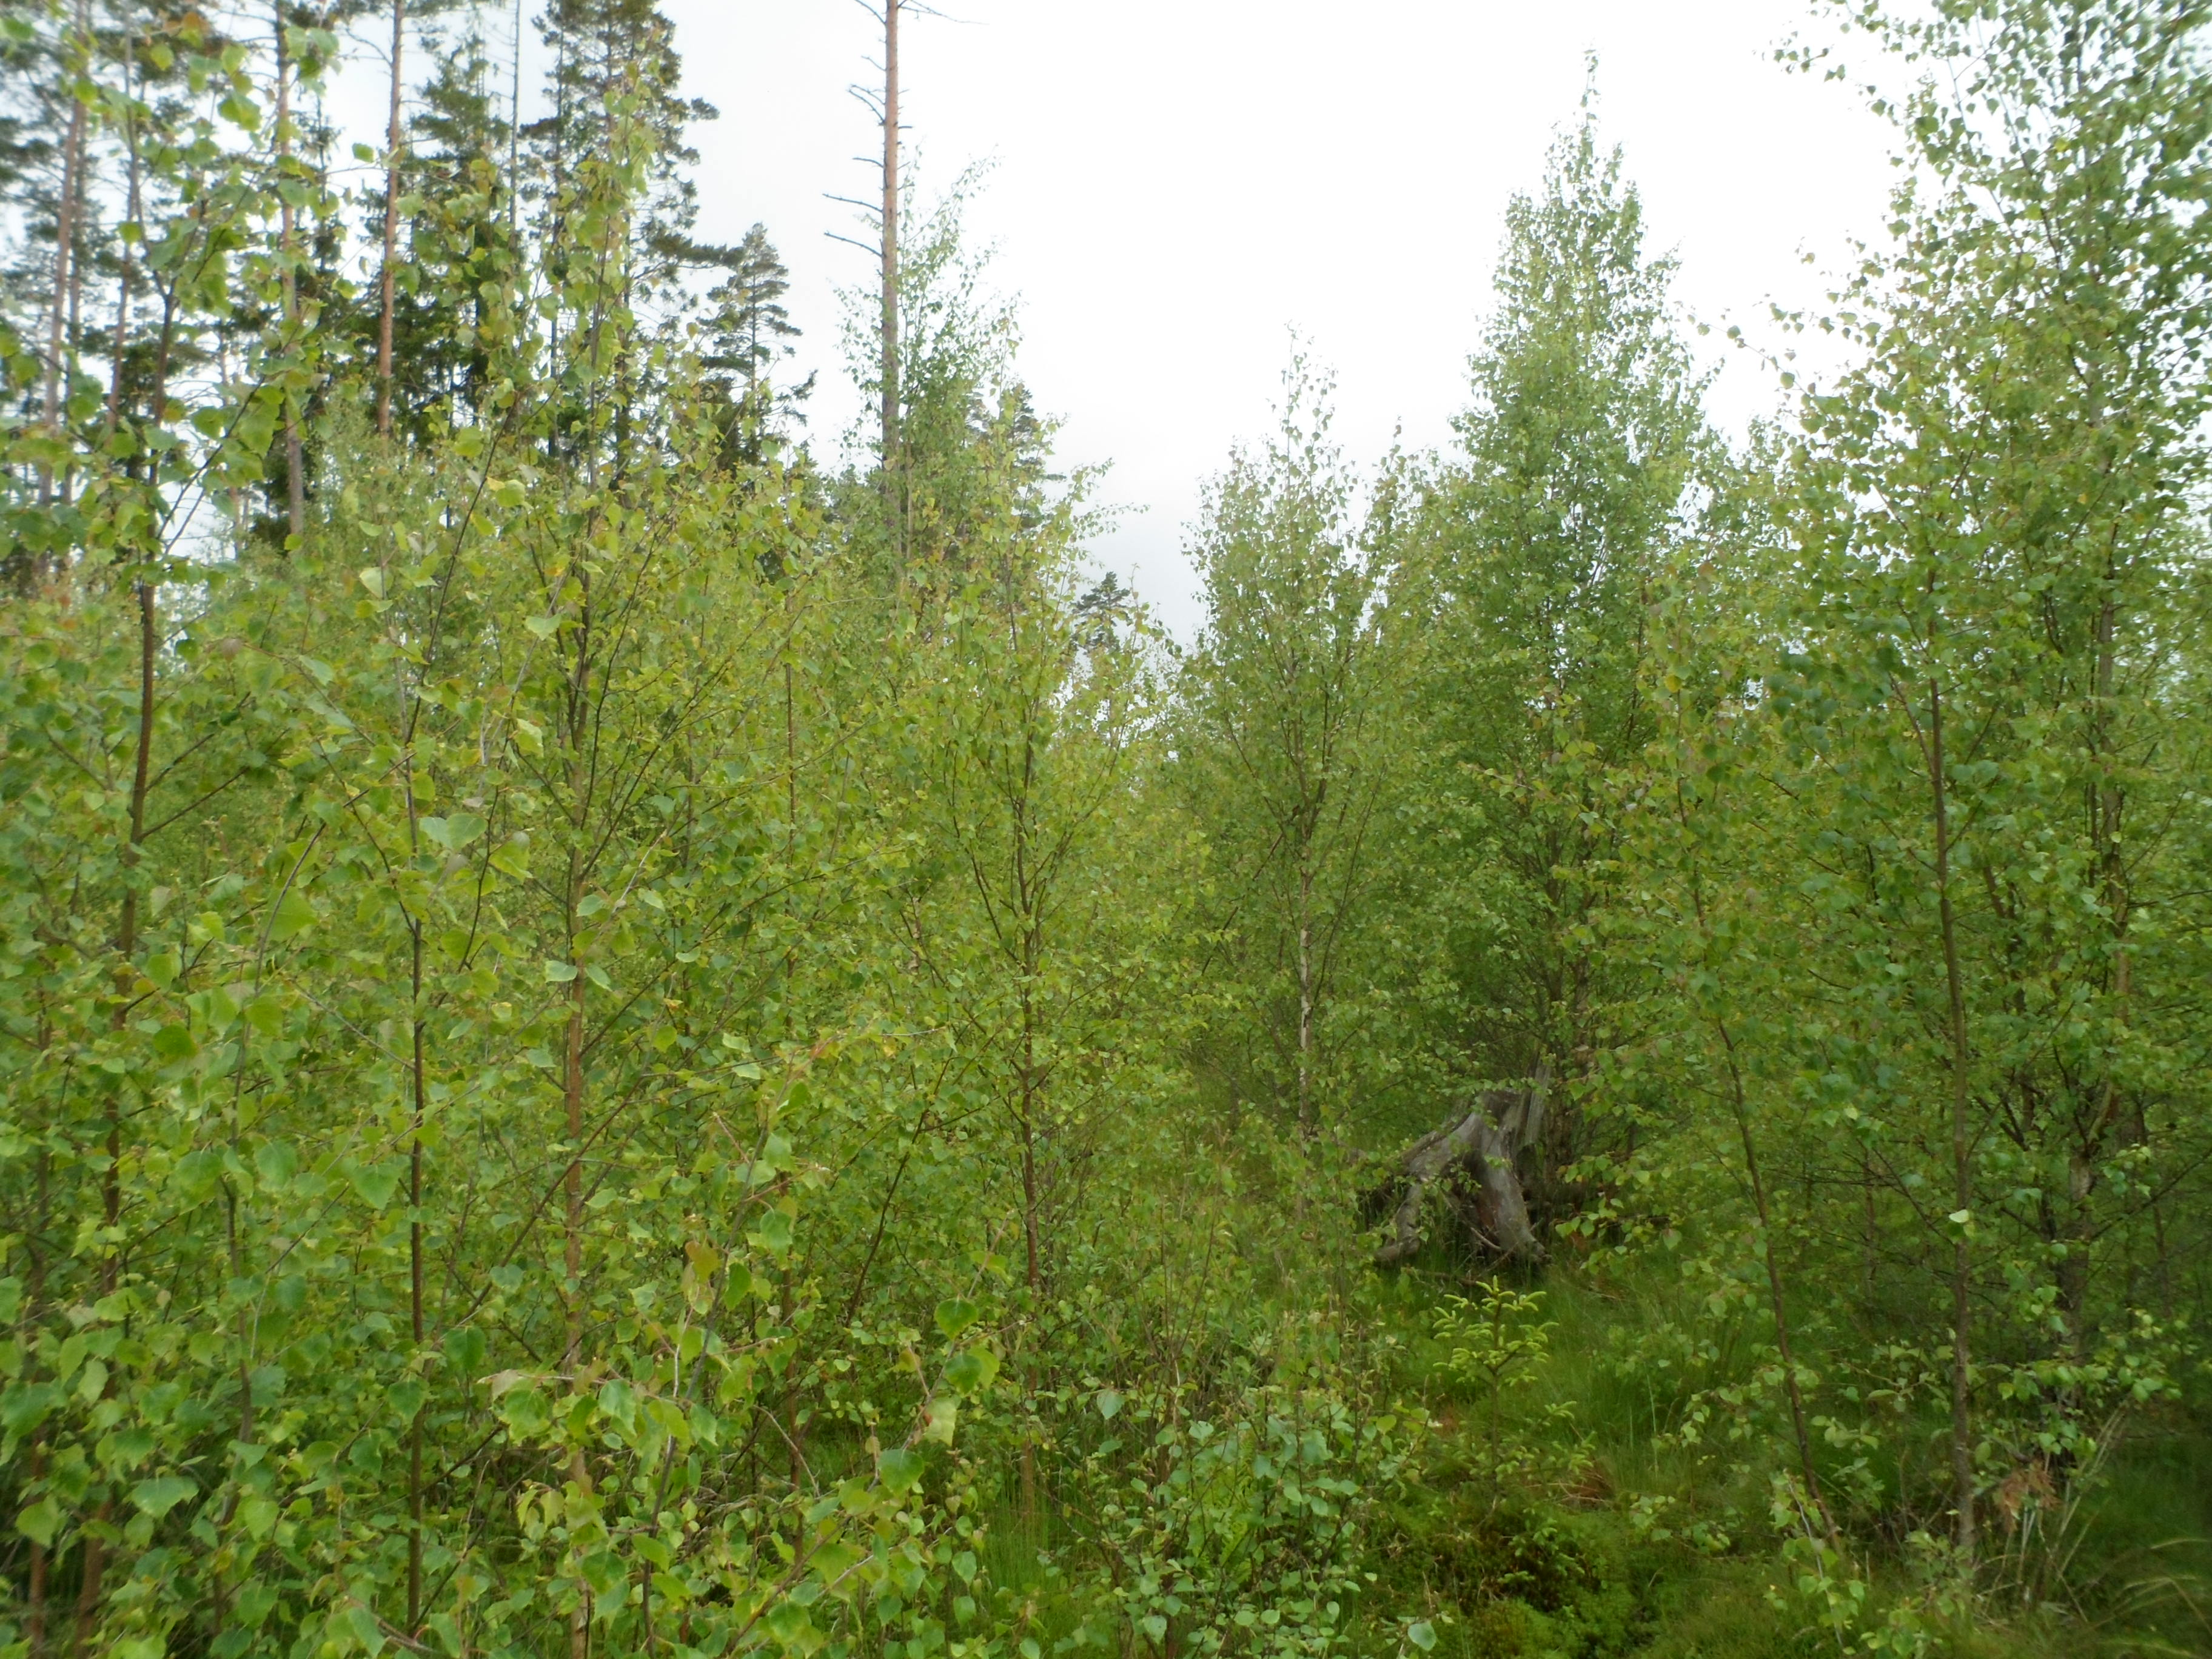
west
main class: Woodland
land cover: Broadleaved woodland
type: boreal forest
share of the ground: > 75 %
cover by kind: broadleaved forest trees 75 %, herbaceous plants 10 %, coniferous forest trees 5 %, shrubs 5 %, lichens and mosses 5 %
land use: Forestry
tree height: < 5 m
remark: Clear cut
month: June
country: SE
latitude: 56.9154
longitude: 14.6124
